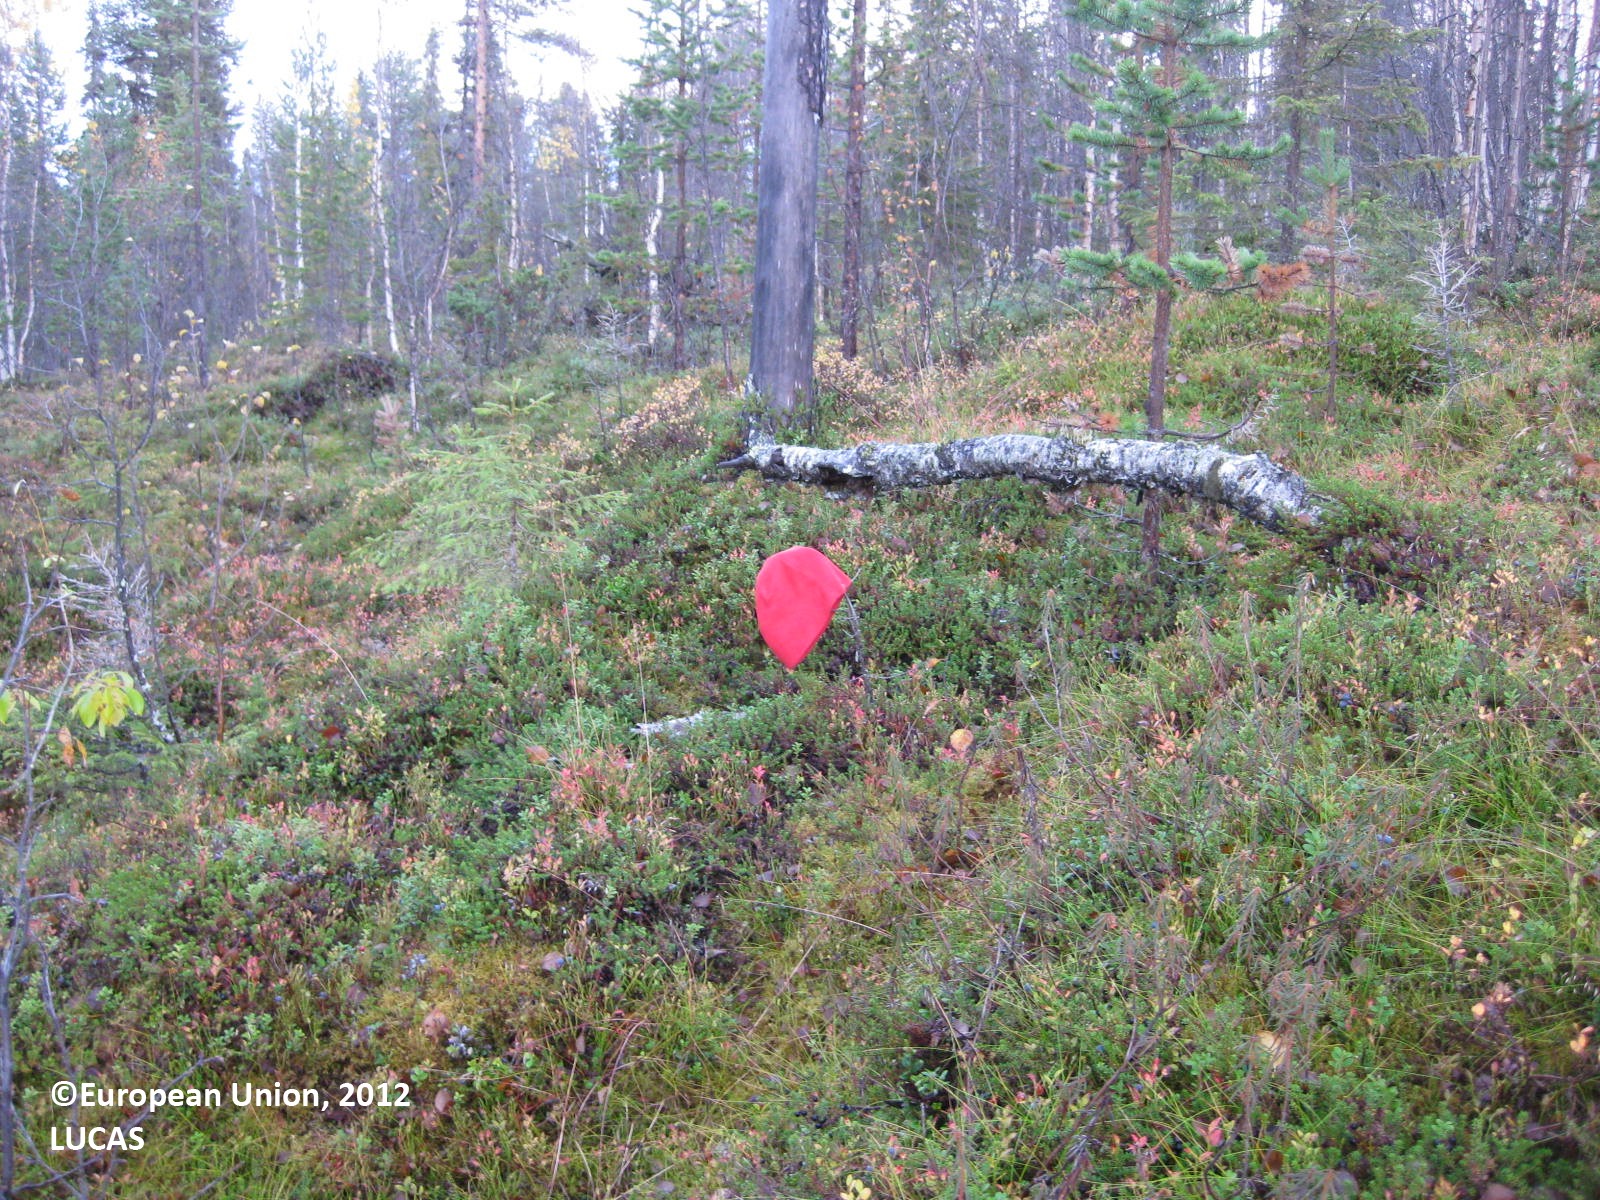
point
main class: Woodland
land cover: Other mixed woodland
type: boreal forest
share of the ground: 25 - 50 %
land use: Semi-natural and natural areas not in use
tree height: > 5 m
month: September
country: FI
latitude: 68.1526
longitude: 24.1504
